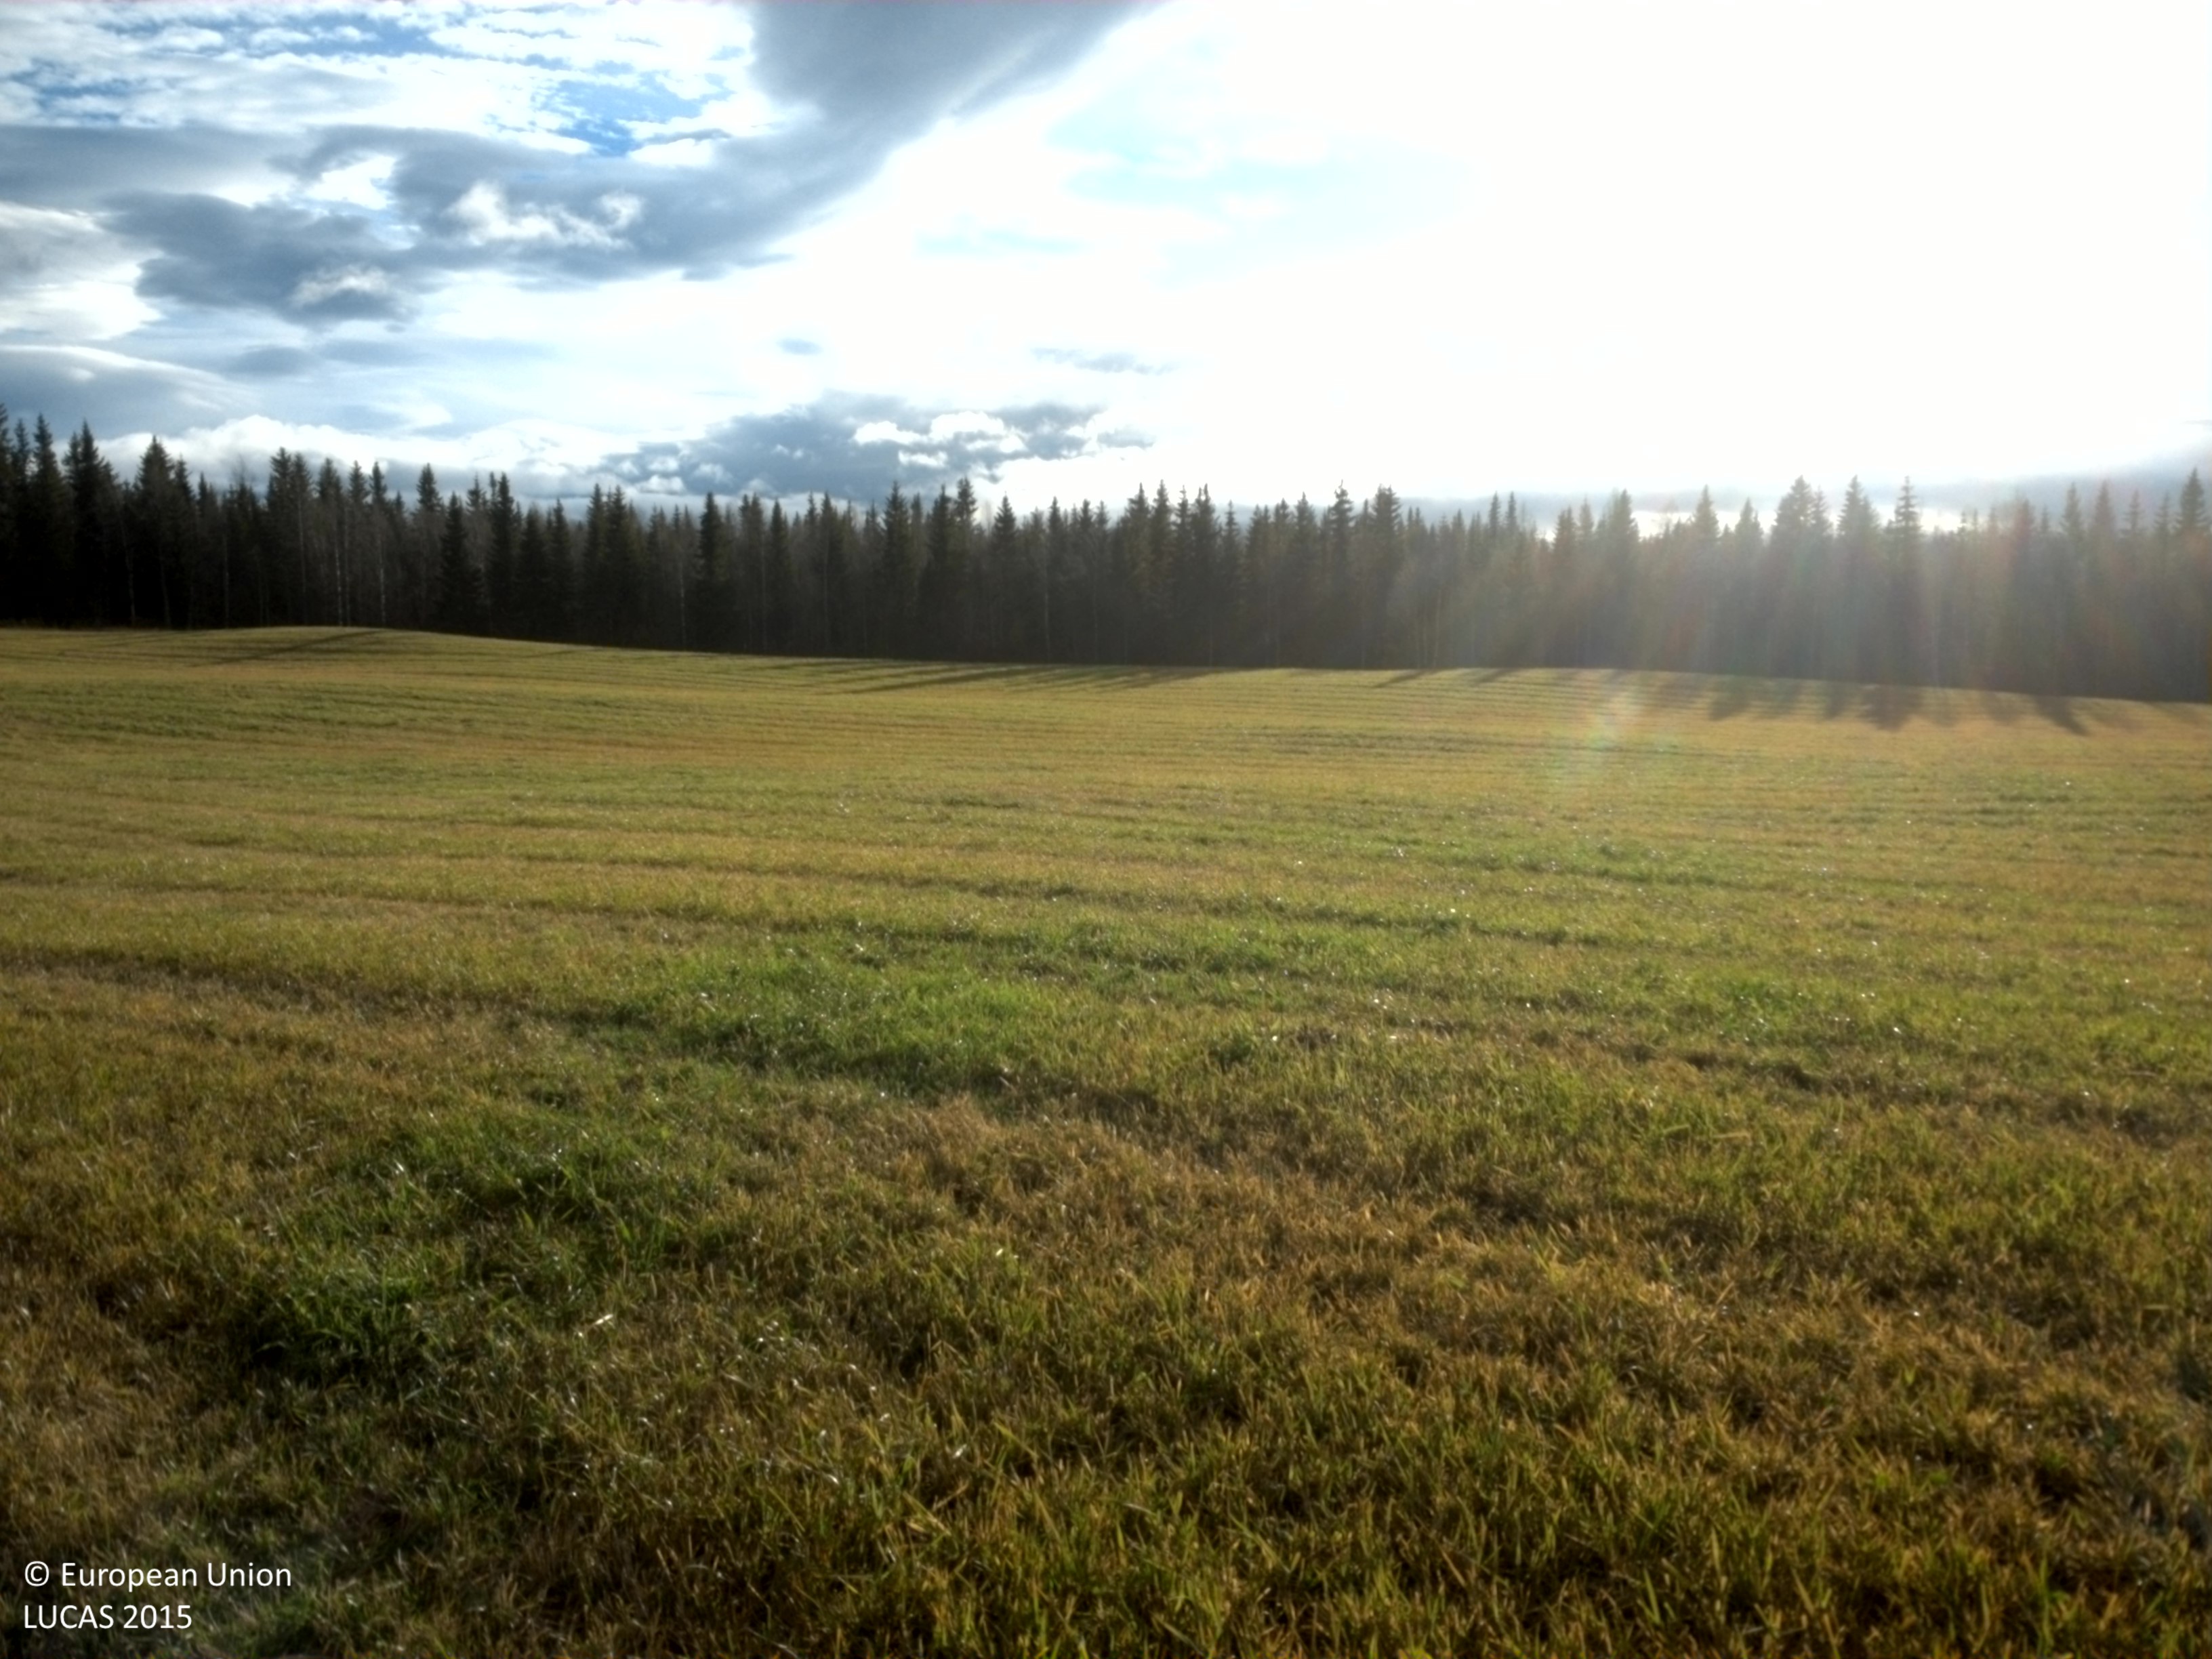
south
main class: Grassland
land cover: Grassland without tree/shrub cover
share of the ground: > 75 %
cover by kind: herbaceous plants 100 %
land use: Agriculture (excluding fallow land and kitchen gardens)
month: October
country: SE
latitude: 64.5405
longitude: 16.4102
